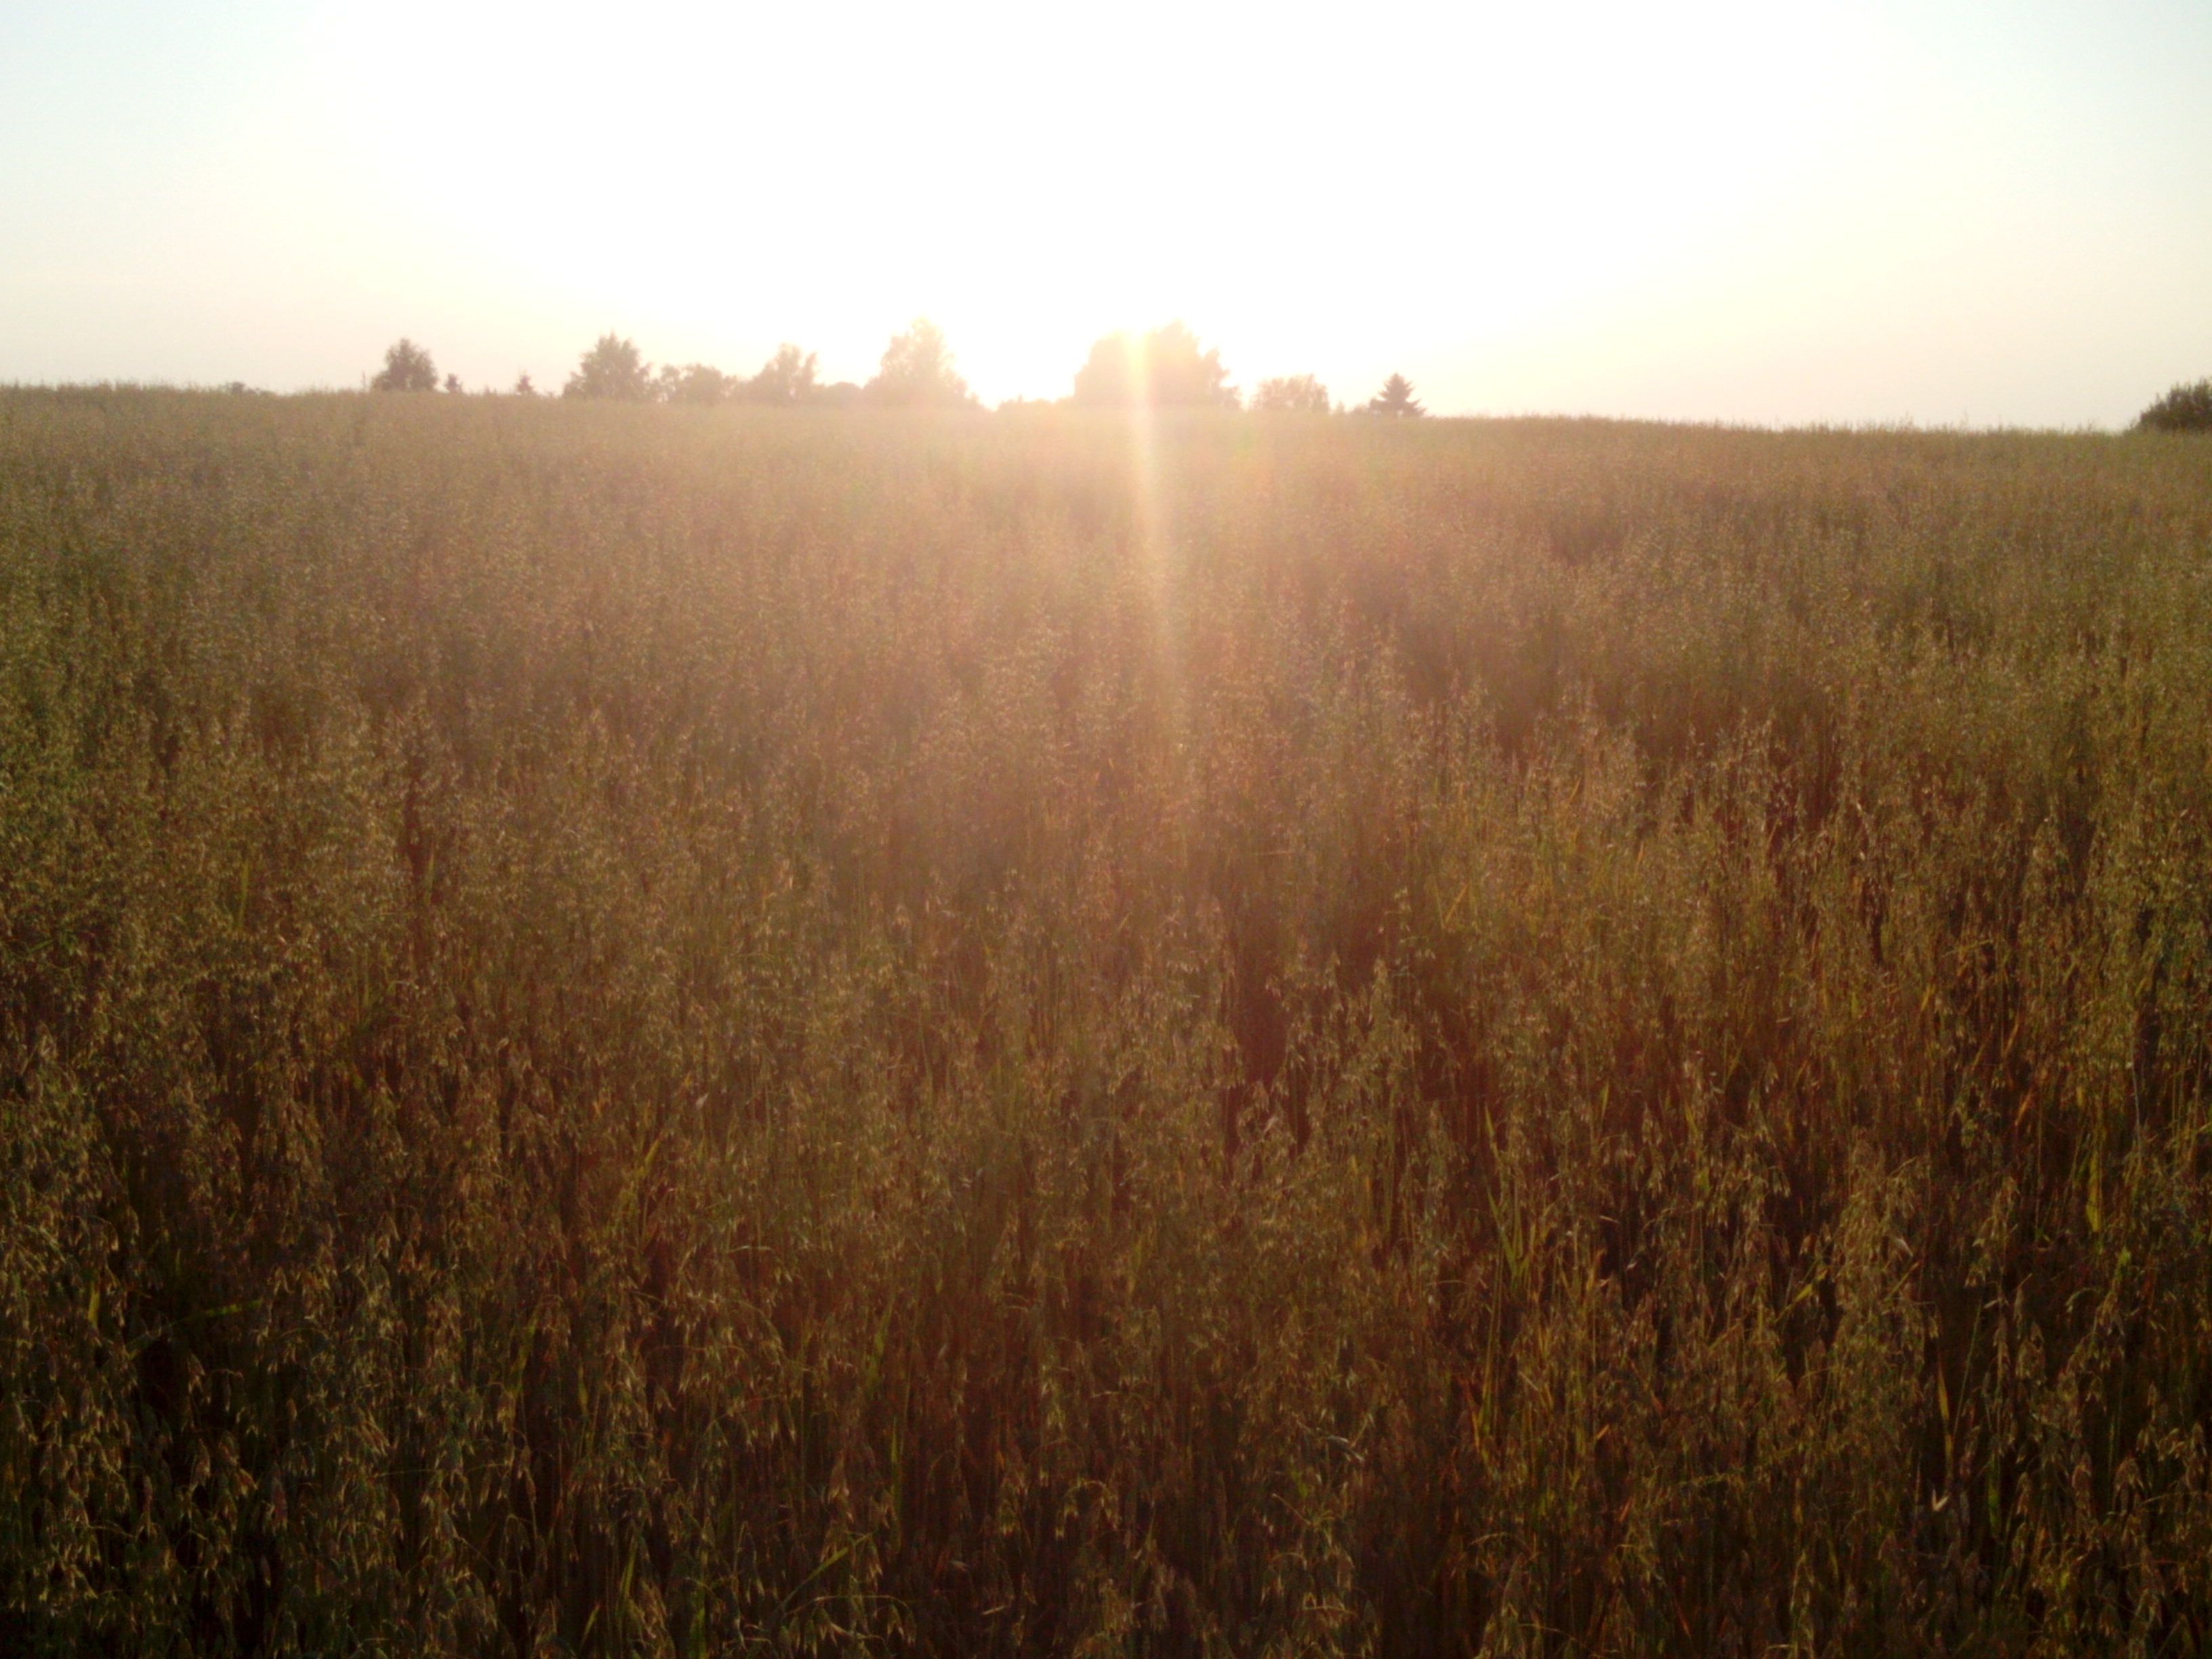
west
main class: Cropland
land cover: Oats
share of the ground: > 75 %
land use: Agriculture (excluding fallow land and kitchen gardens)
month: August
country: LV
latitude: 56.9777
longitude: 21.7082
